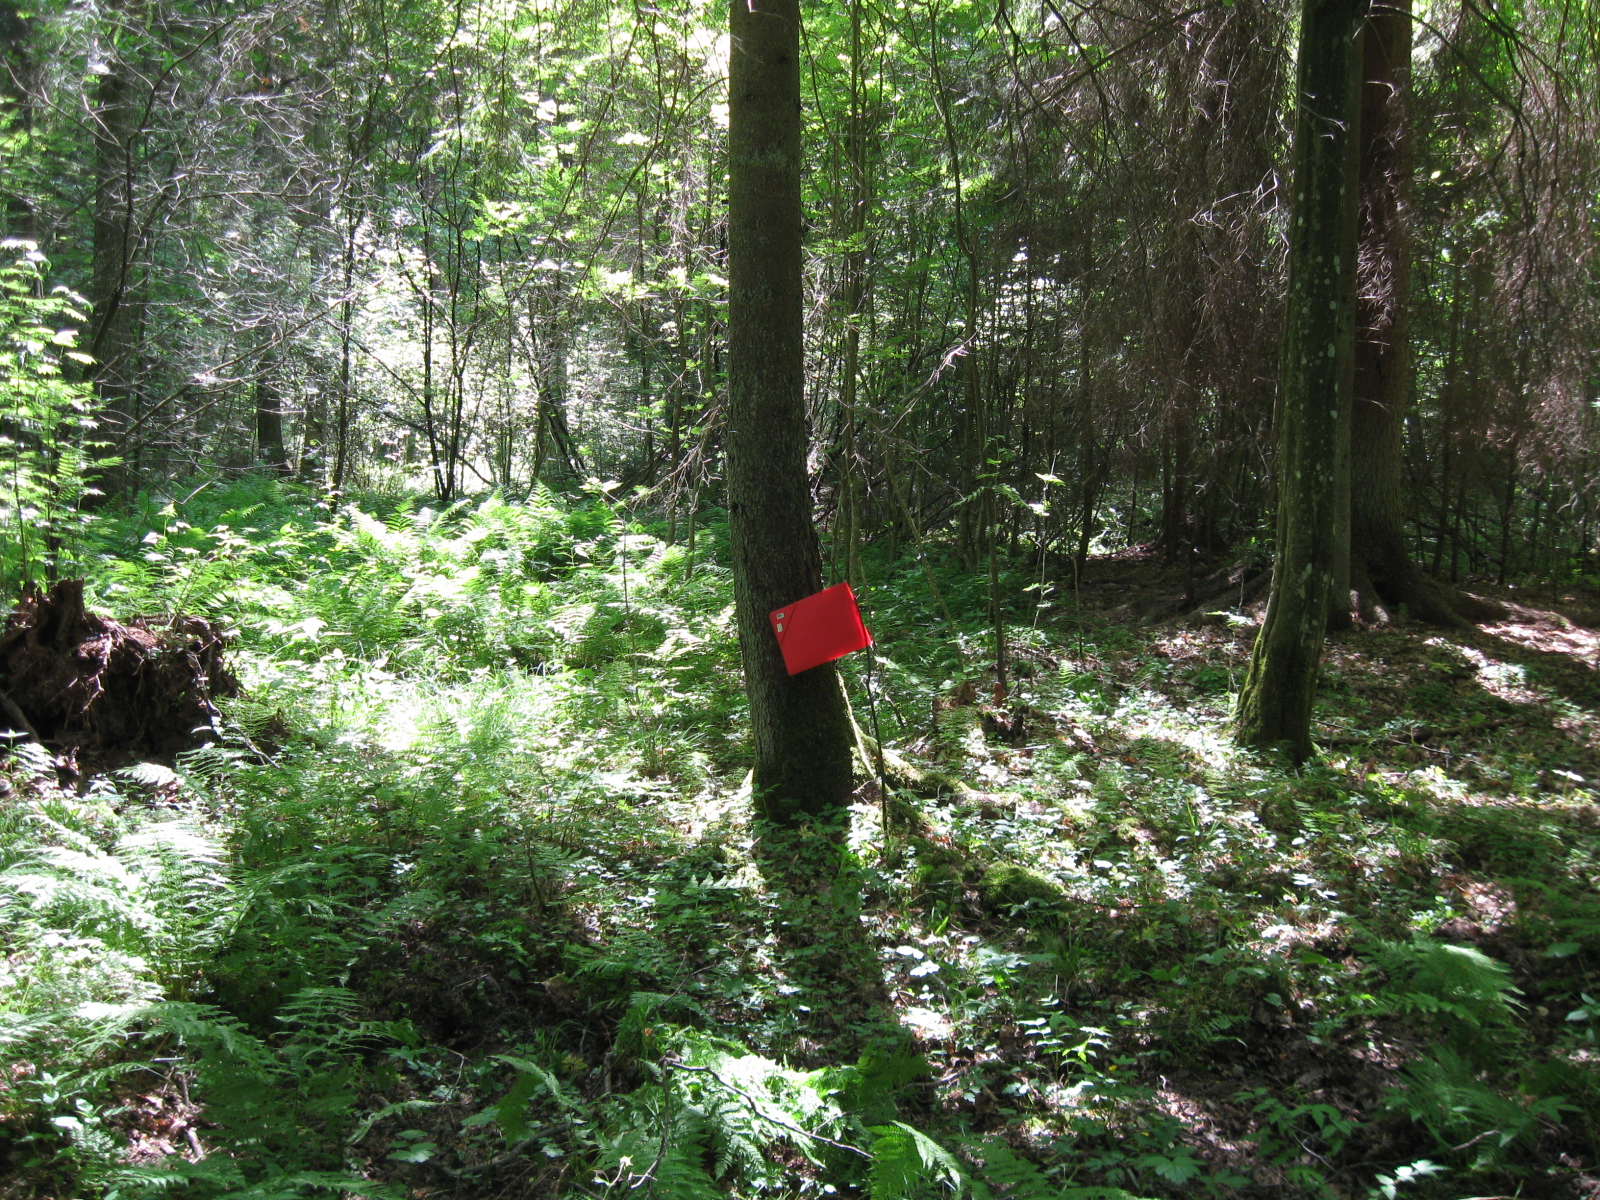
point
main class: Woodland
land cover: Spruce dominated mixed woodland
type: hemiboreal forest and nemoral coniferous forest and mixed broadleaved-coniferous forest
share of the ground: > 75 %
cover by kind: broadleaved forest trees 50 %, coniferous forest trees 45 %, herbaceous plants 5 %
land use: Forestry
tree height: > 5 m
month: June
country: LT
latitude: 54.5809
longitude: 23.7800
